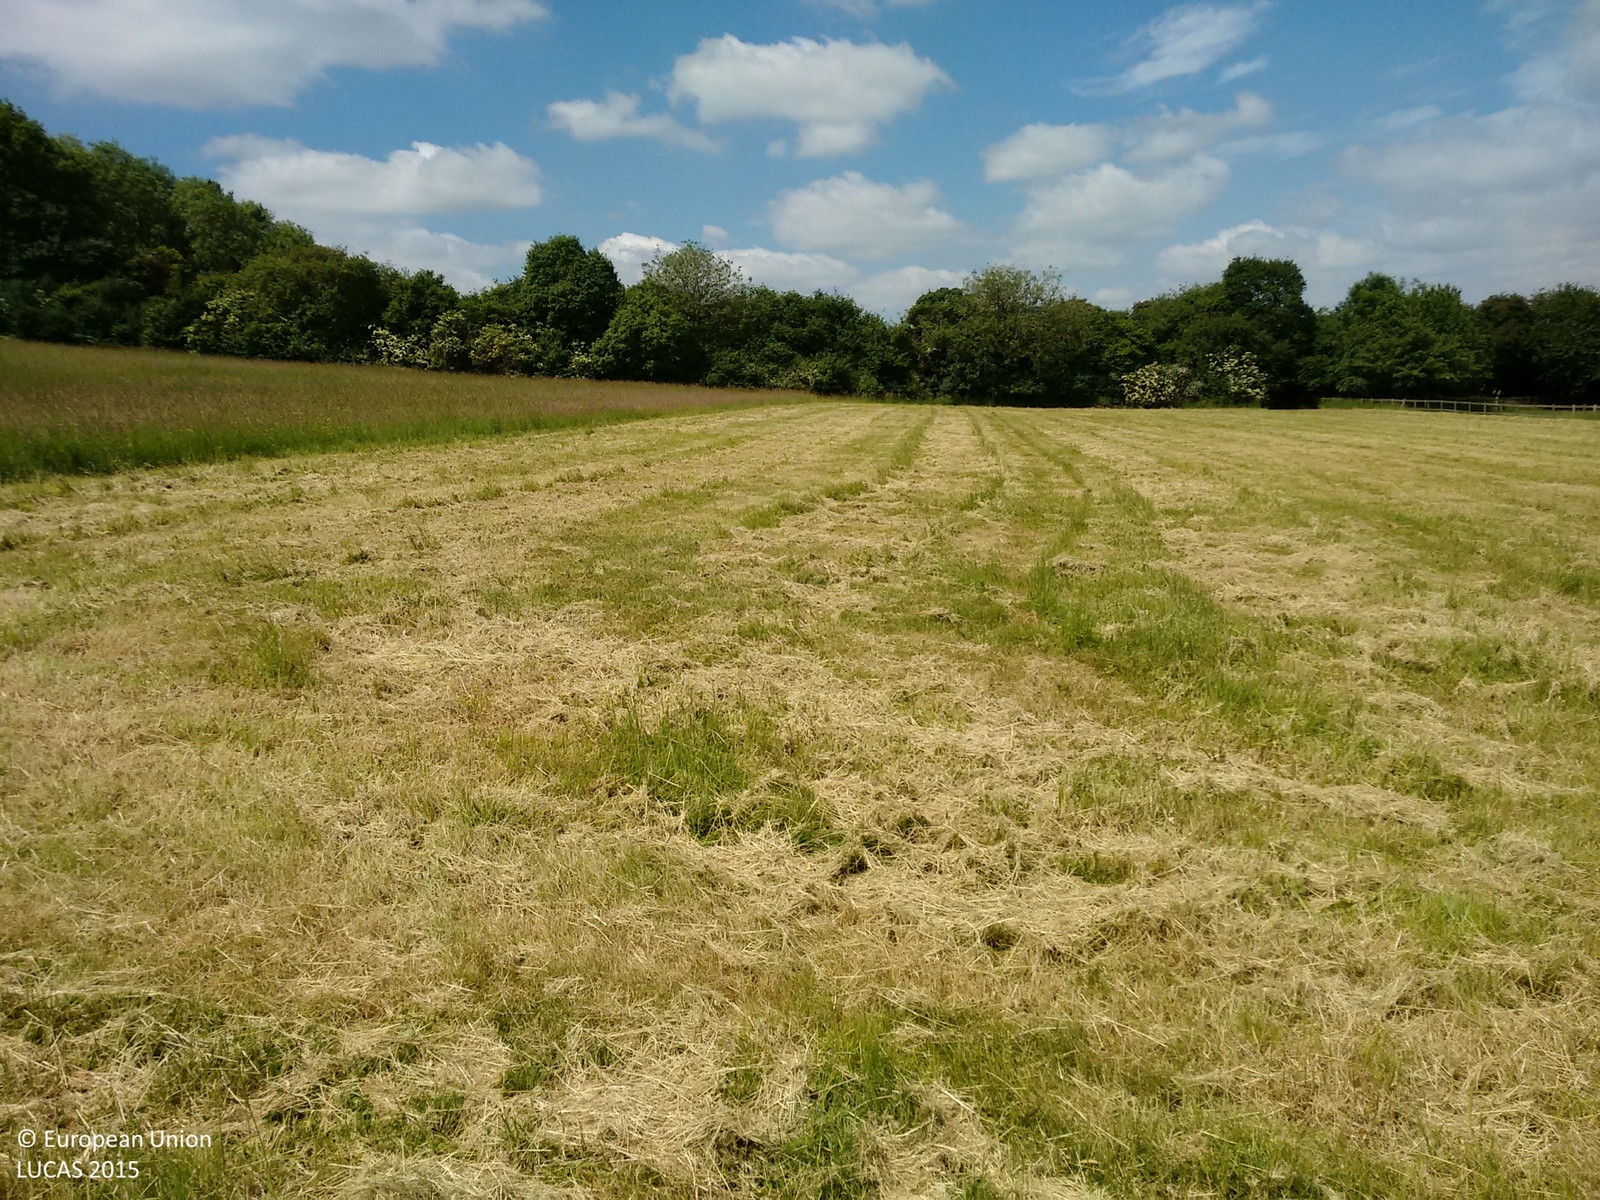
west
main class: Grassland
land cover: Grassland without tree/shrub cover
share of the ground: > 75 %
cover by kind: herbaceous plants 100 %
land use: Agriculture (excluding fallow land and kitchen gardens)
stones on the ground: 10 - 25 %
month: June
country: GB
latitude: 51.4894
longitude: -1.5009
